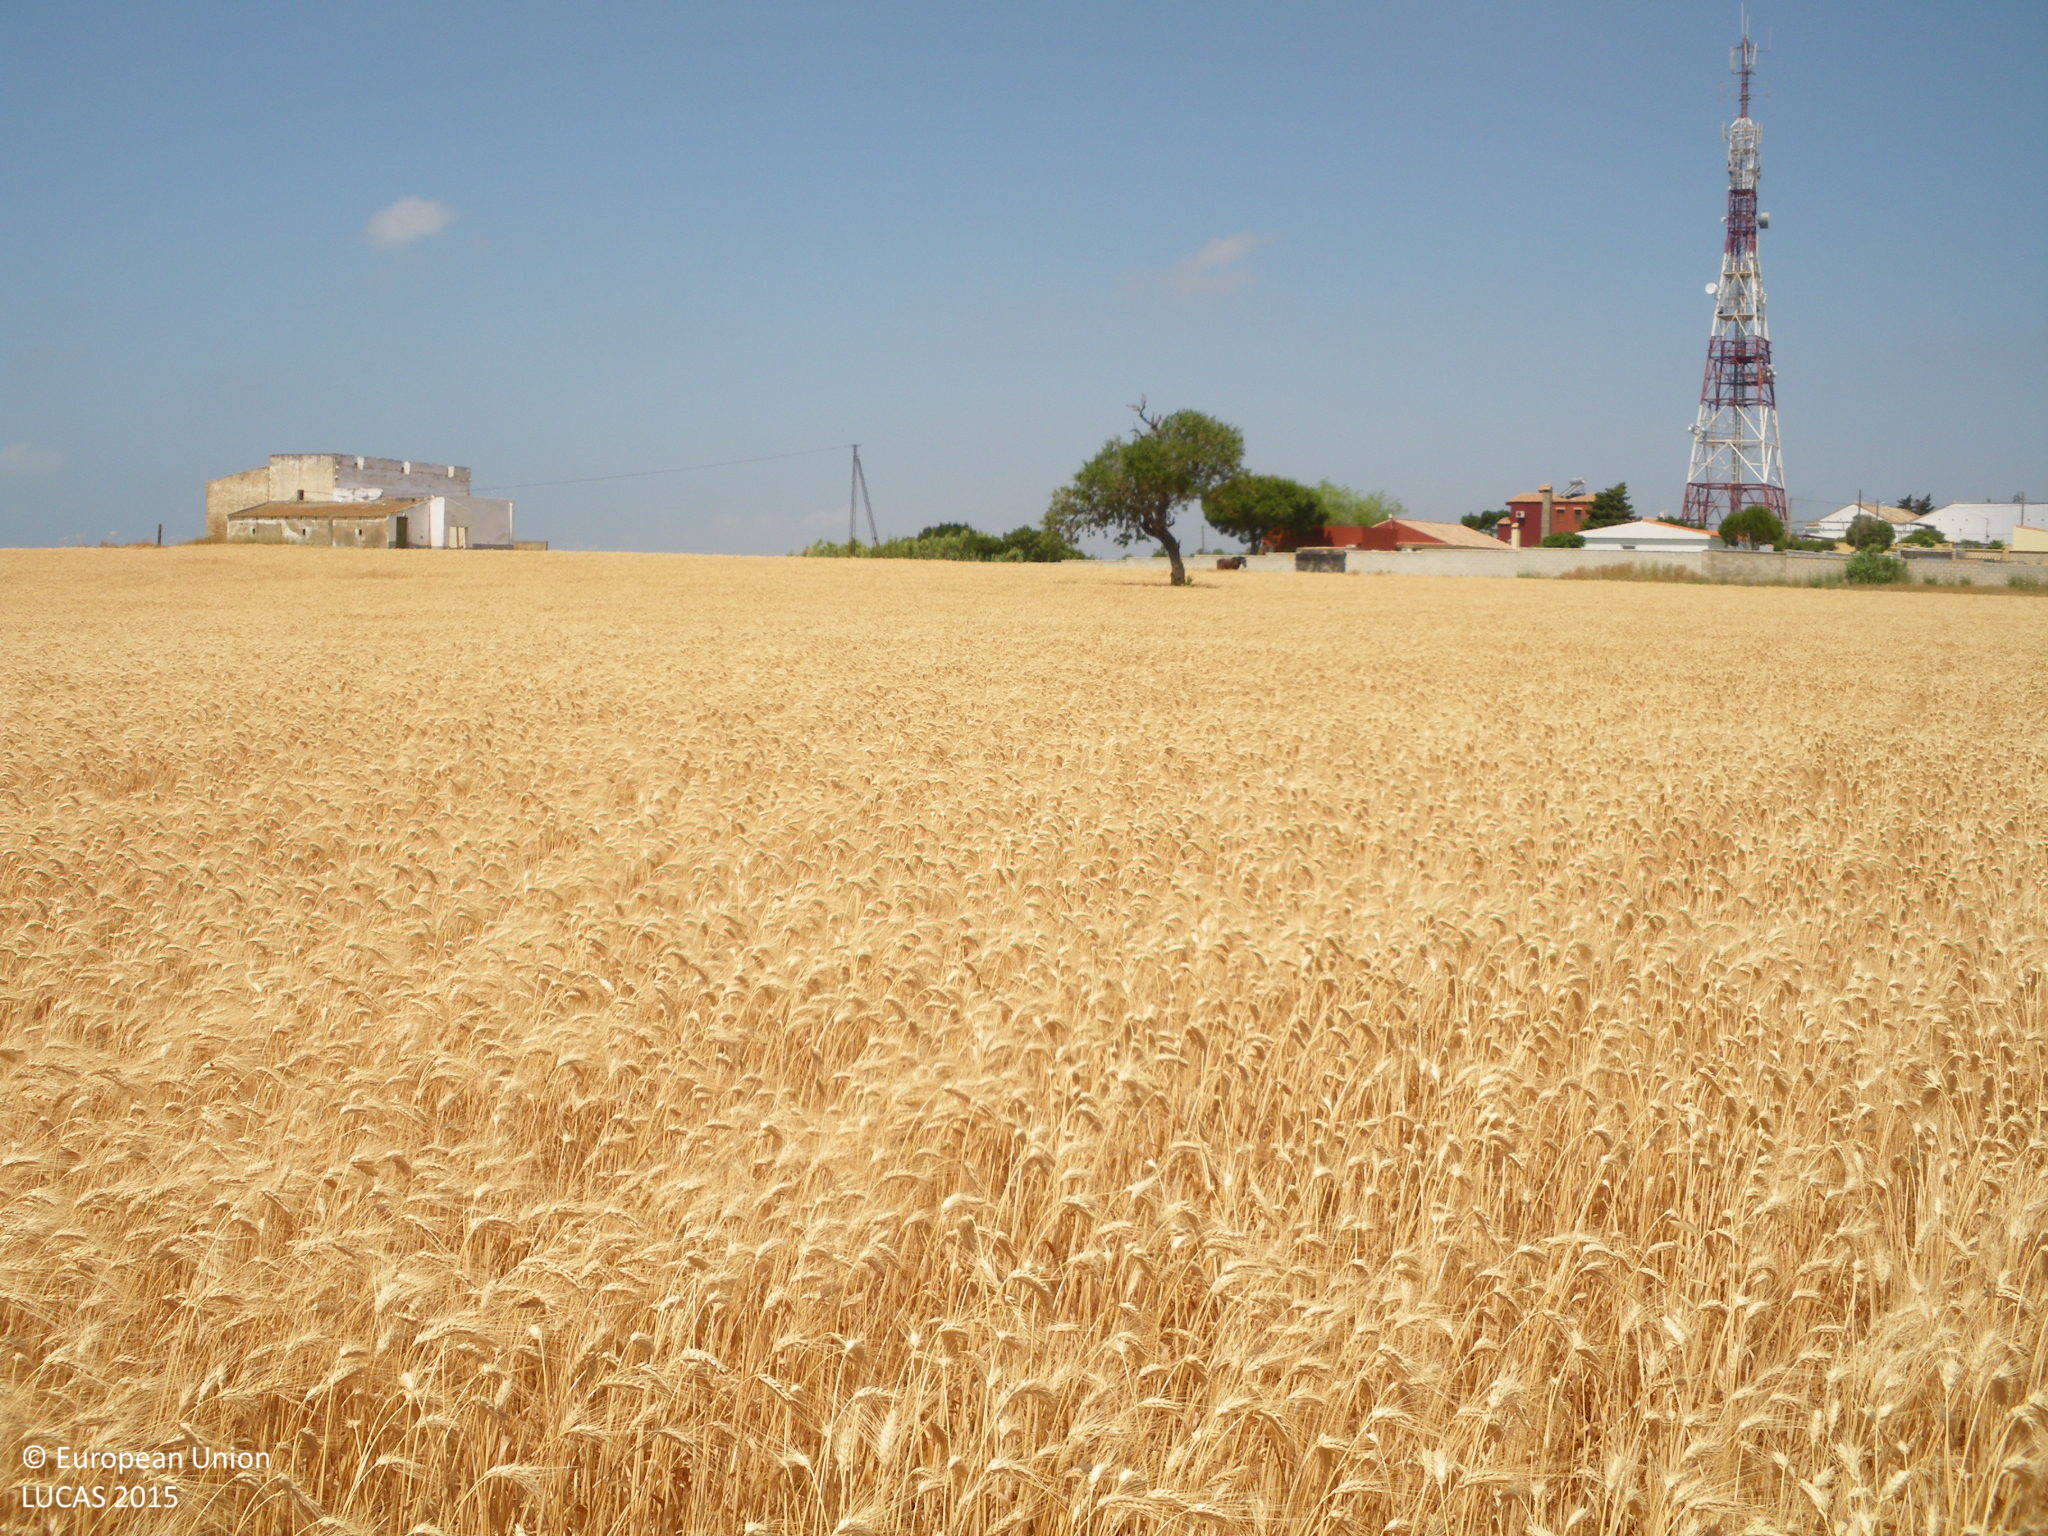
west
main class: Cropland
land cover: Durum wheat
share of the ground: > 75 %
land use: Agriculture (excluding fallow land and kitchen gardens)
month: May
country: ES
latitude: 36.5239
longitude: -6.1466
